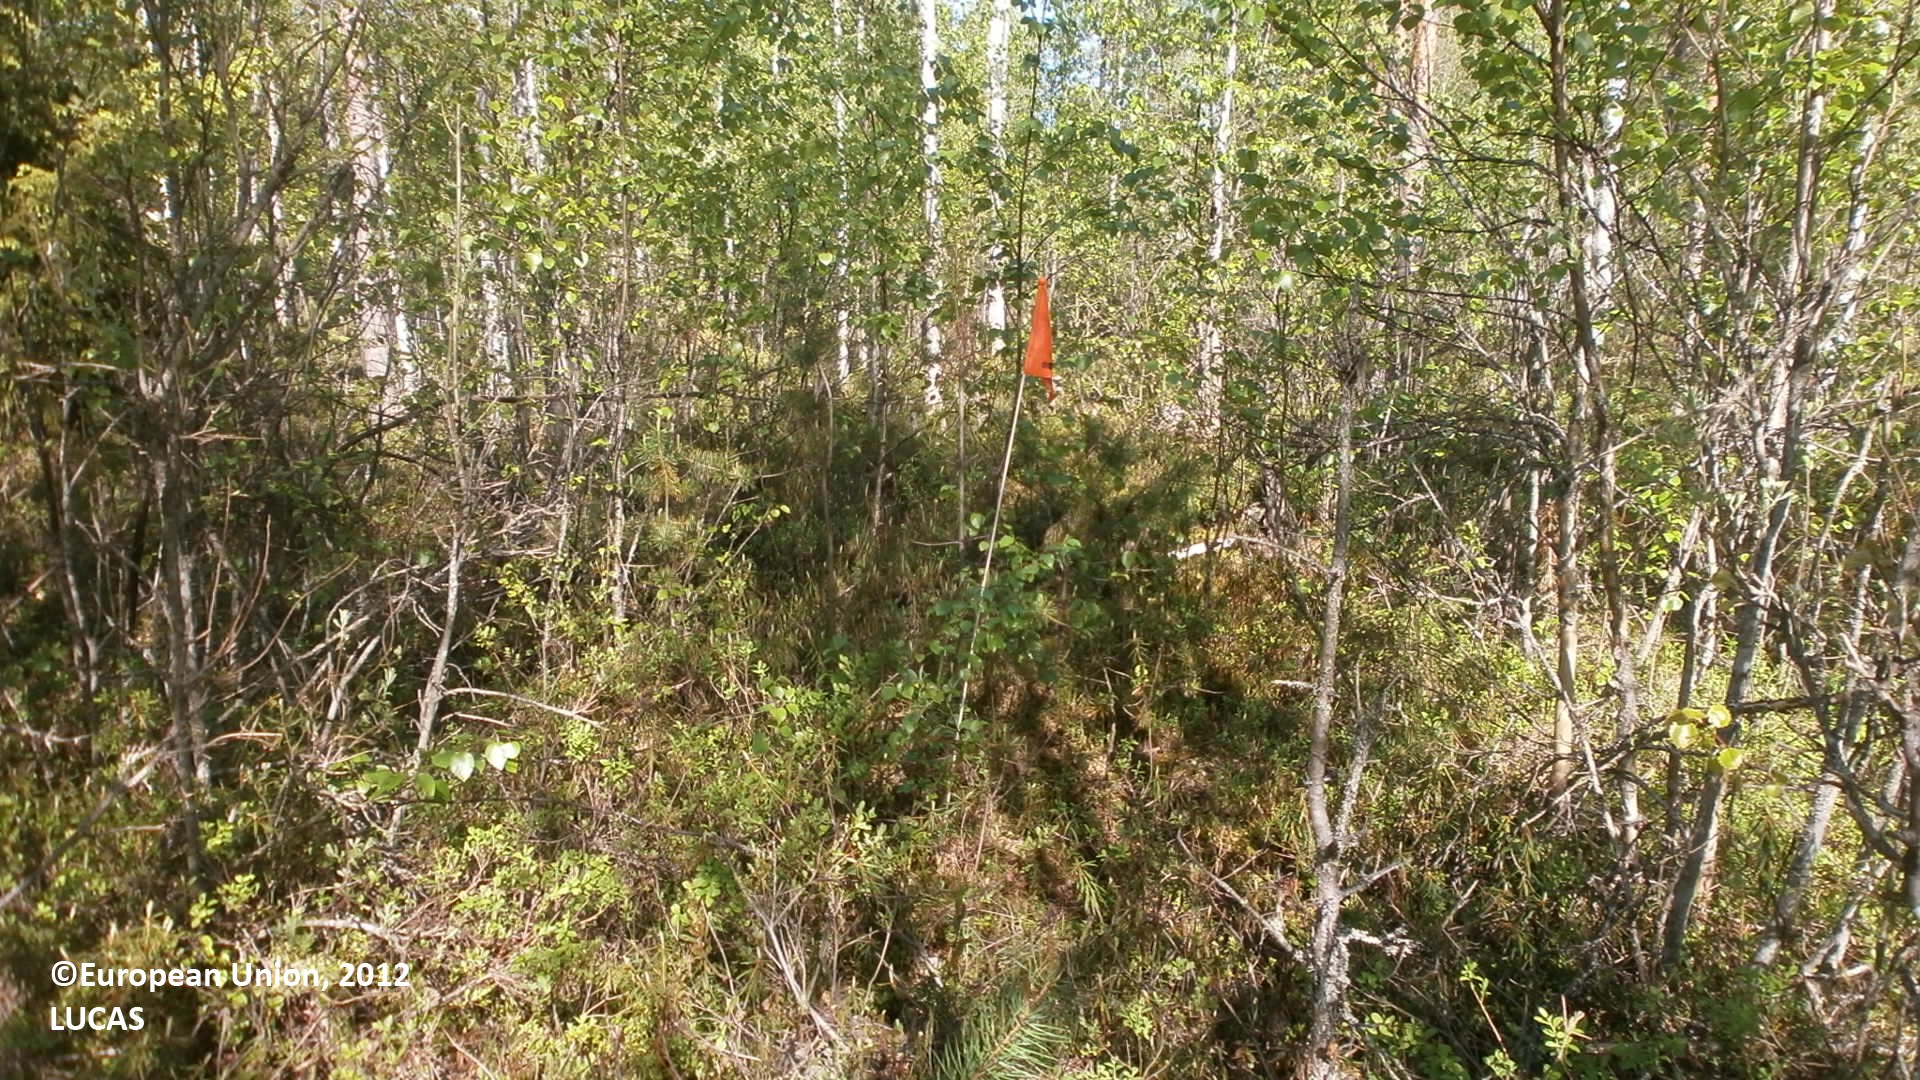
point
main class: Woodland
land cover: Broadleaved woodland
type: mire and swamp forests
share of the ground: 50 - 75 %
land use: Forestry
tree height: > 5 m
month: June
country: FI
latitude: 64.1379
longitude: 25.7782
